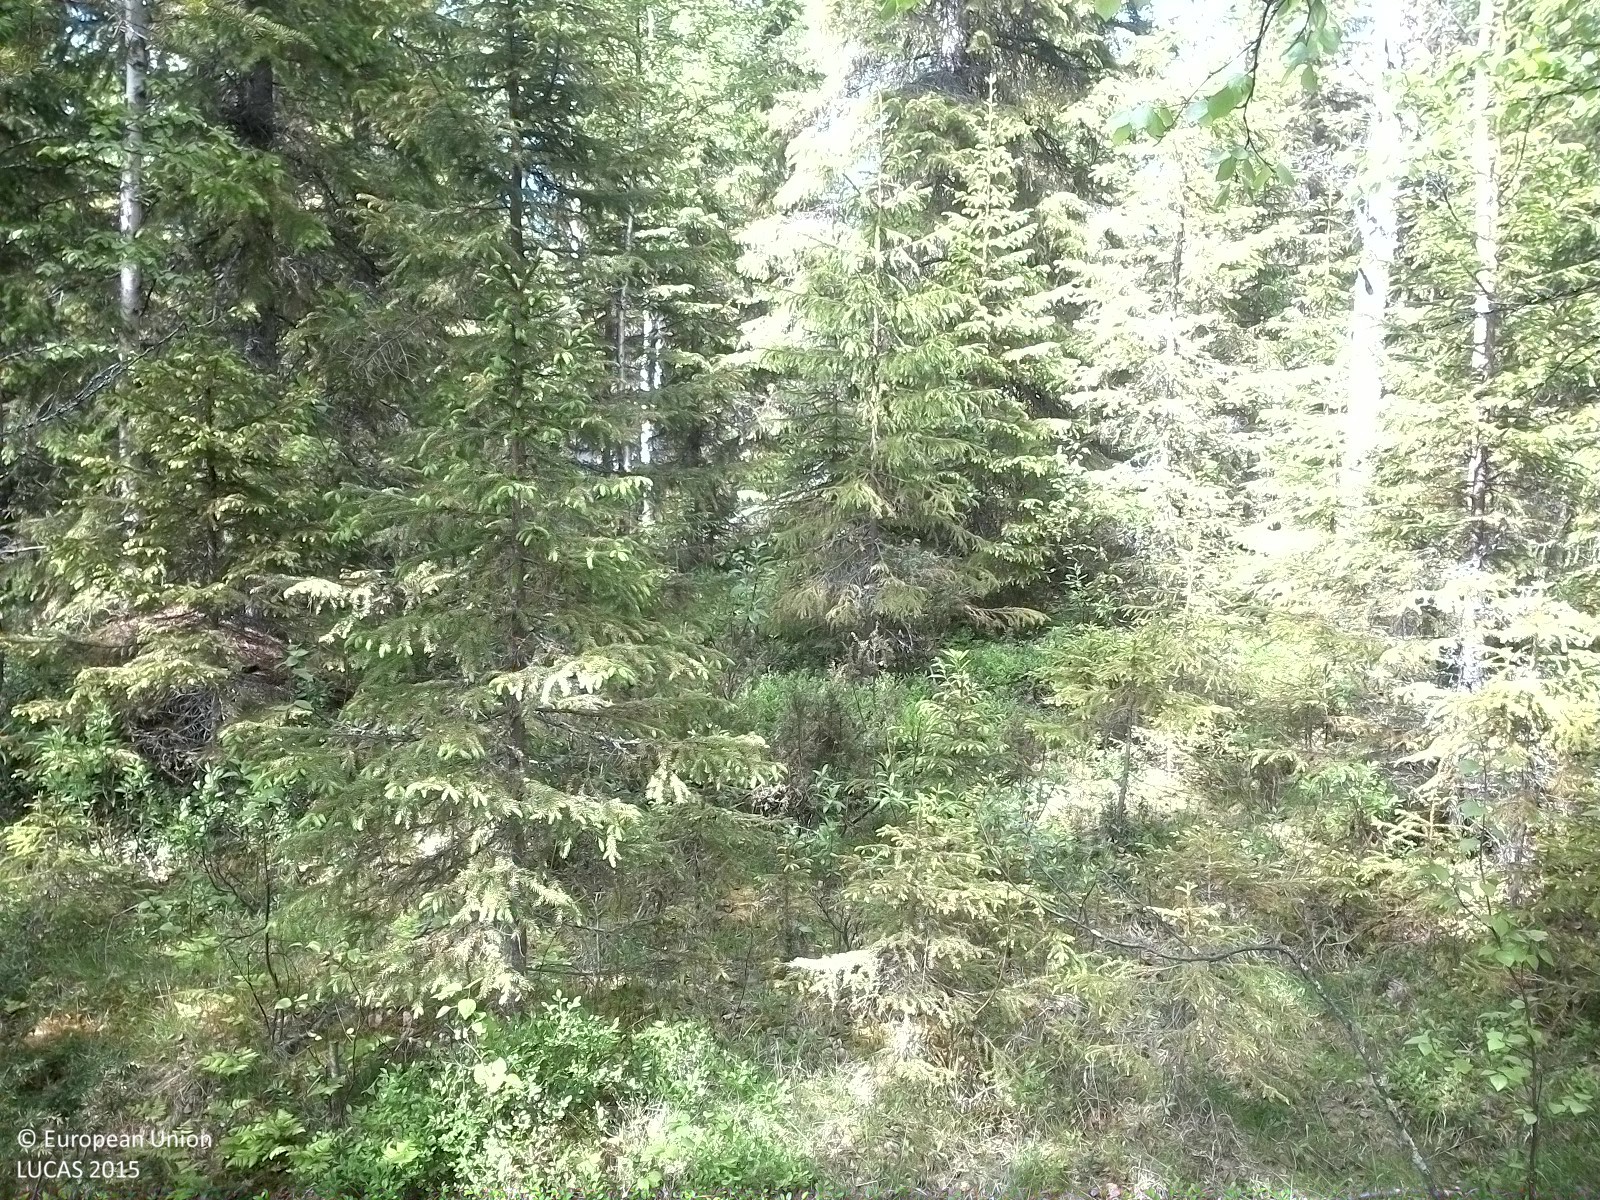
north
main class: Woodland
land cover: Spruce dominated mixed woodland
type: boreal forest
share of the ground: > 75 %
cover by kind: coniferous forest trees 65 %, broadleaved forest trees 25 %, shrubs 10 %
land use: Forestry
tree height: > 5 m
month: June
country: SE
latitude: 63.5314
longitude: 15.3046
